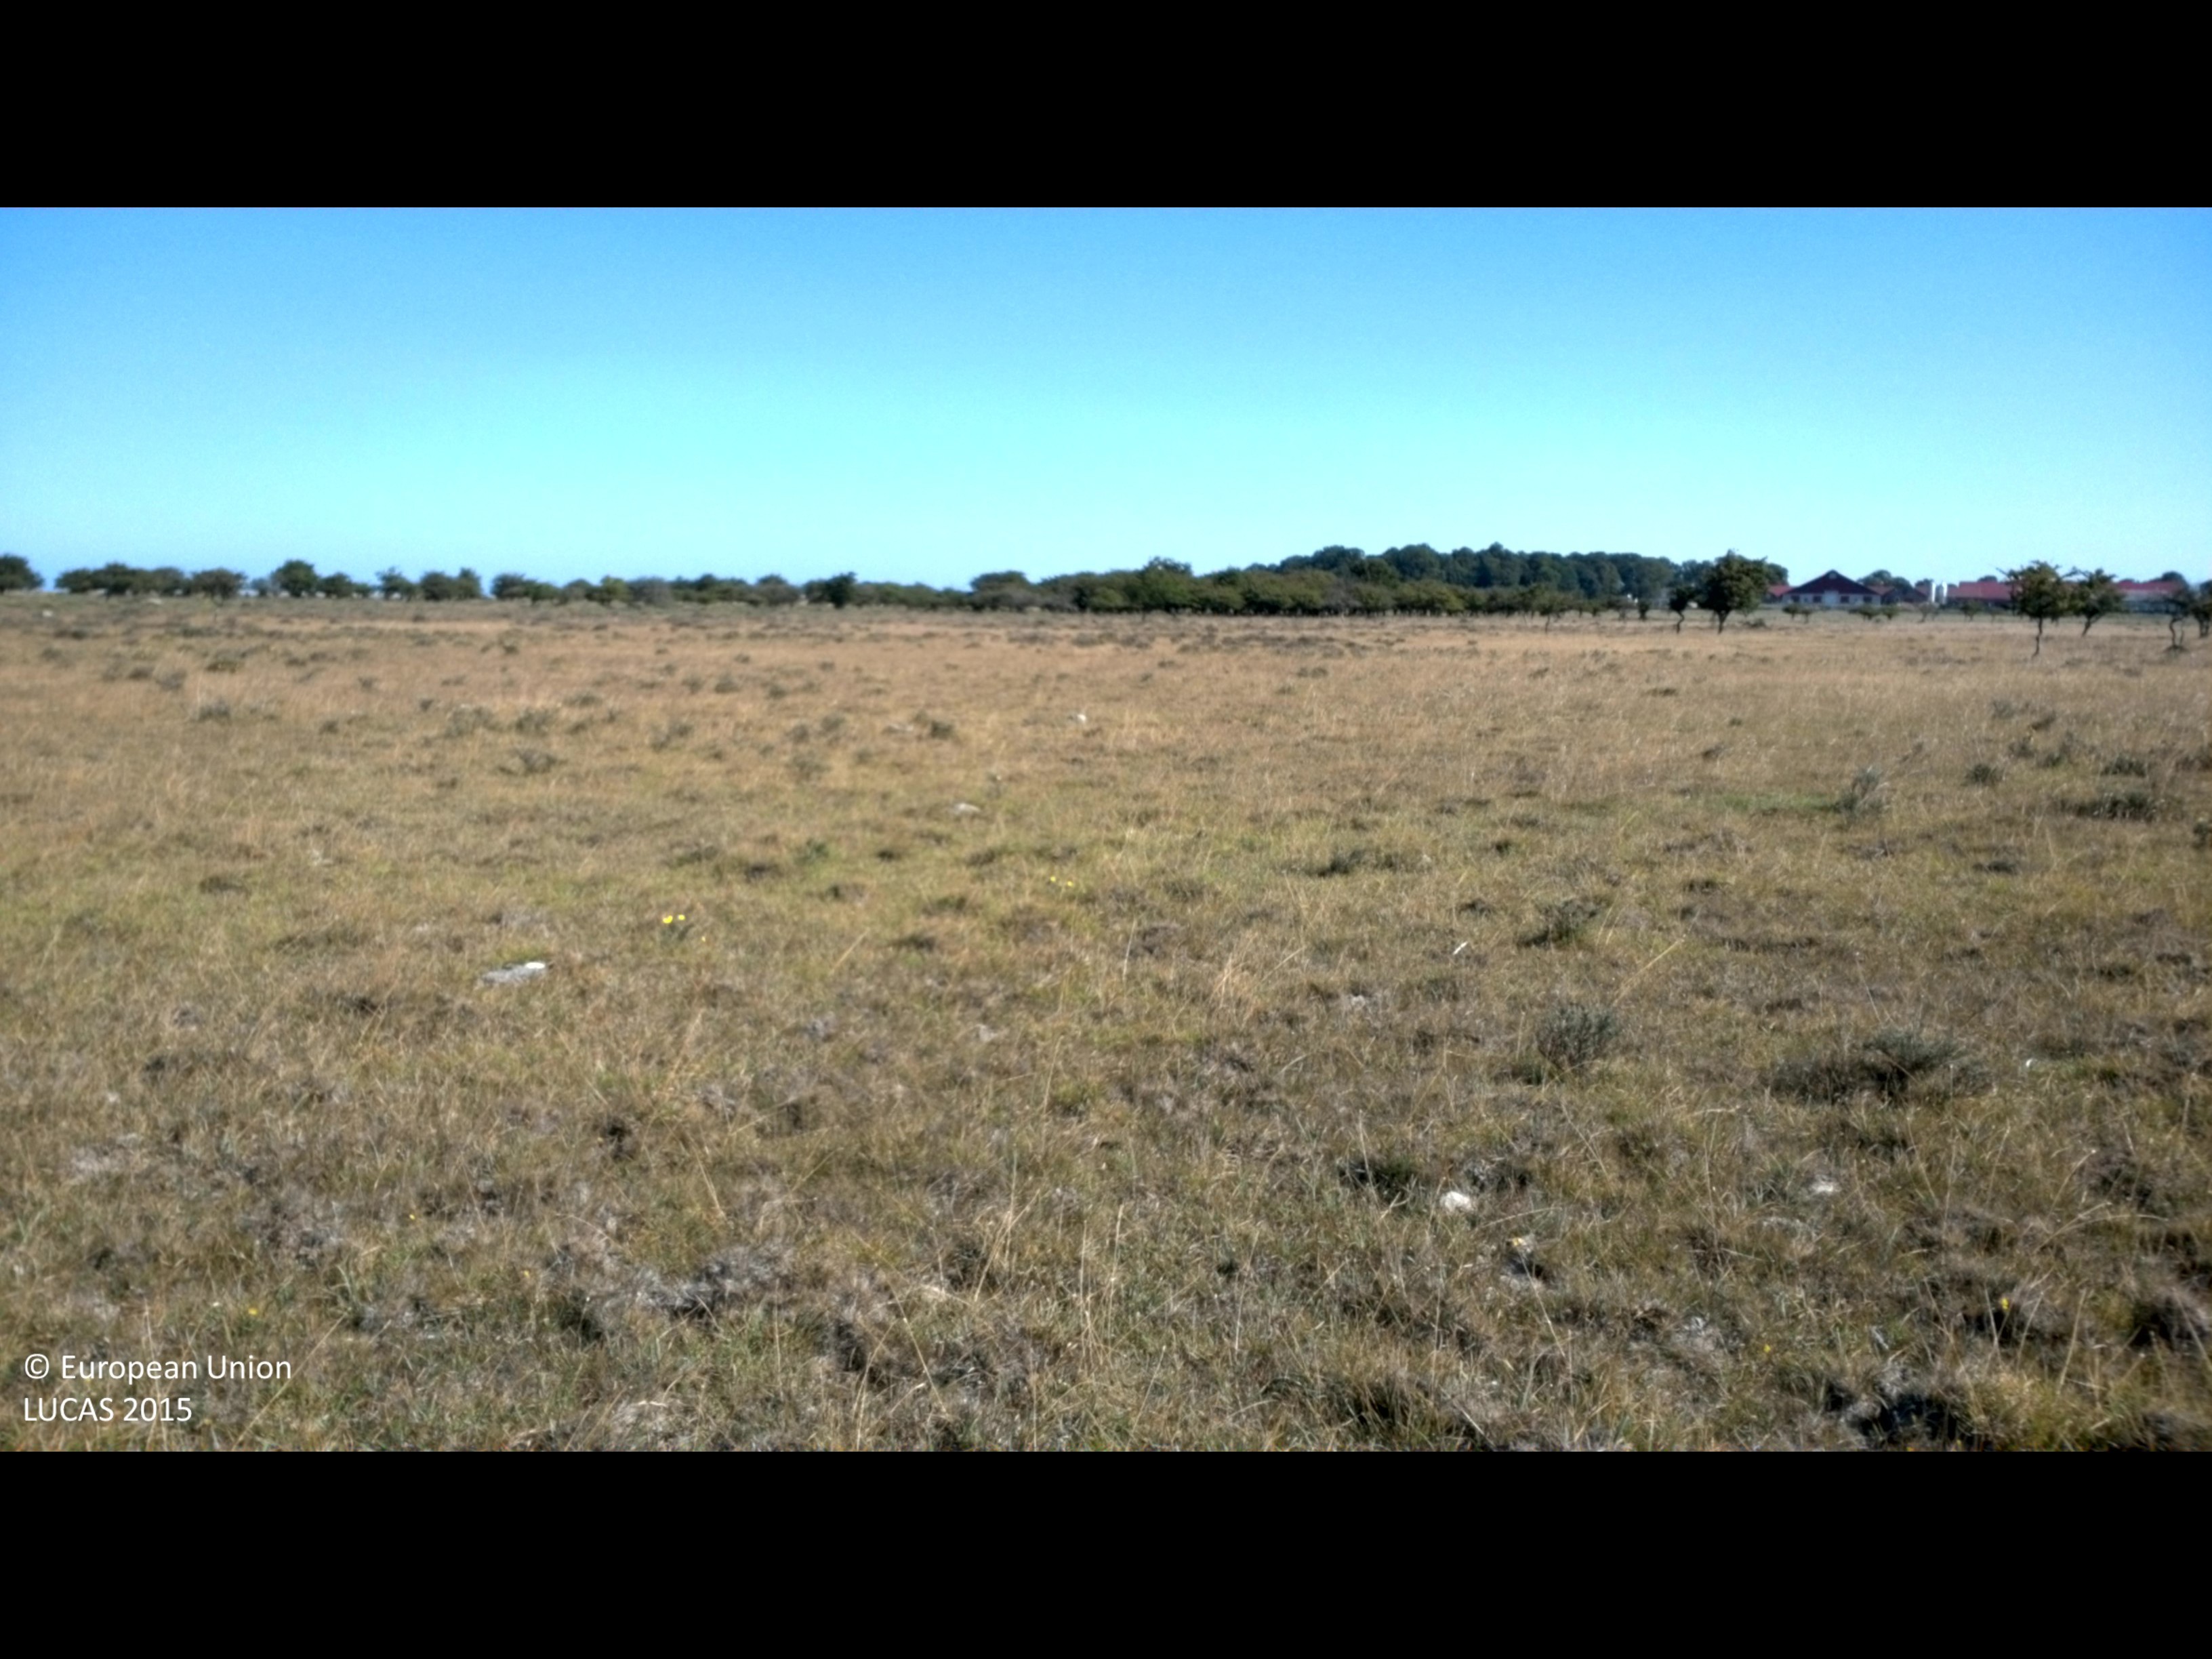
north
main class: Grassland
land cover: Grassland without tree/shrub cover
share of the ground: > 75 %
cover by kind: herbaceous plants 100 %
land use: Agriculture (excluding fallow land and kitchen gardens)
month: July
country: SE
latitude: 56.2263
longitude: 16.4054
